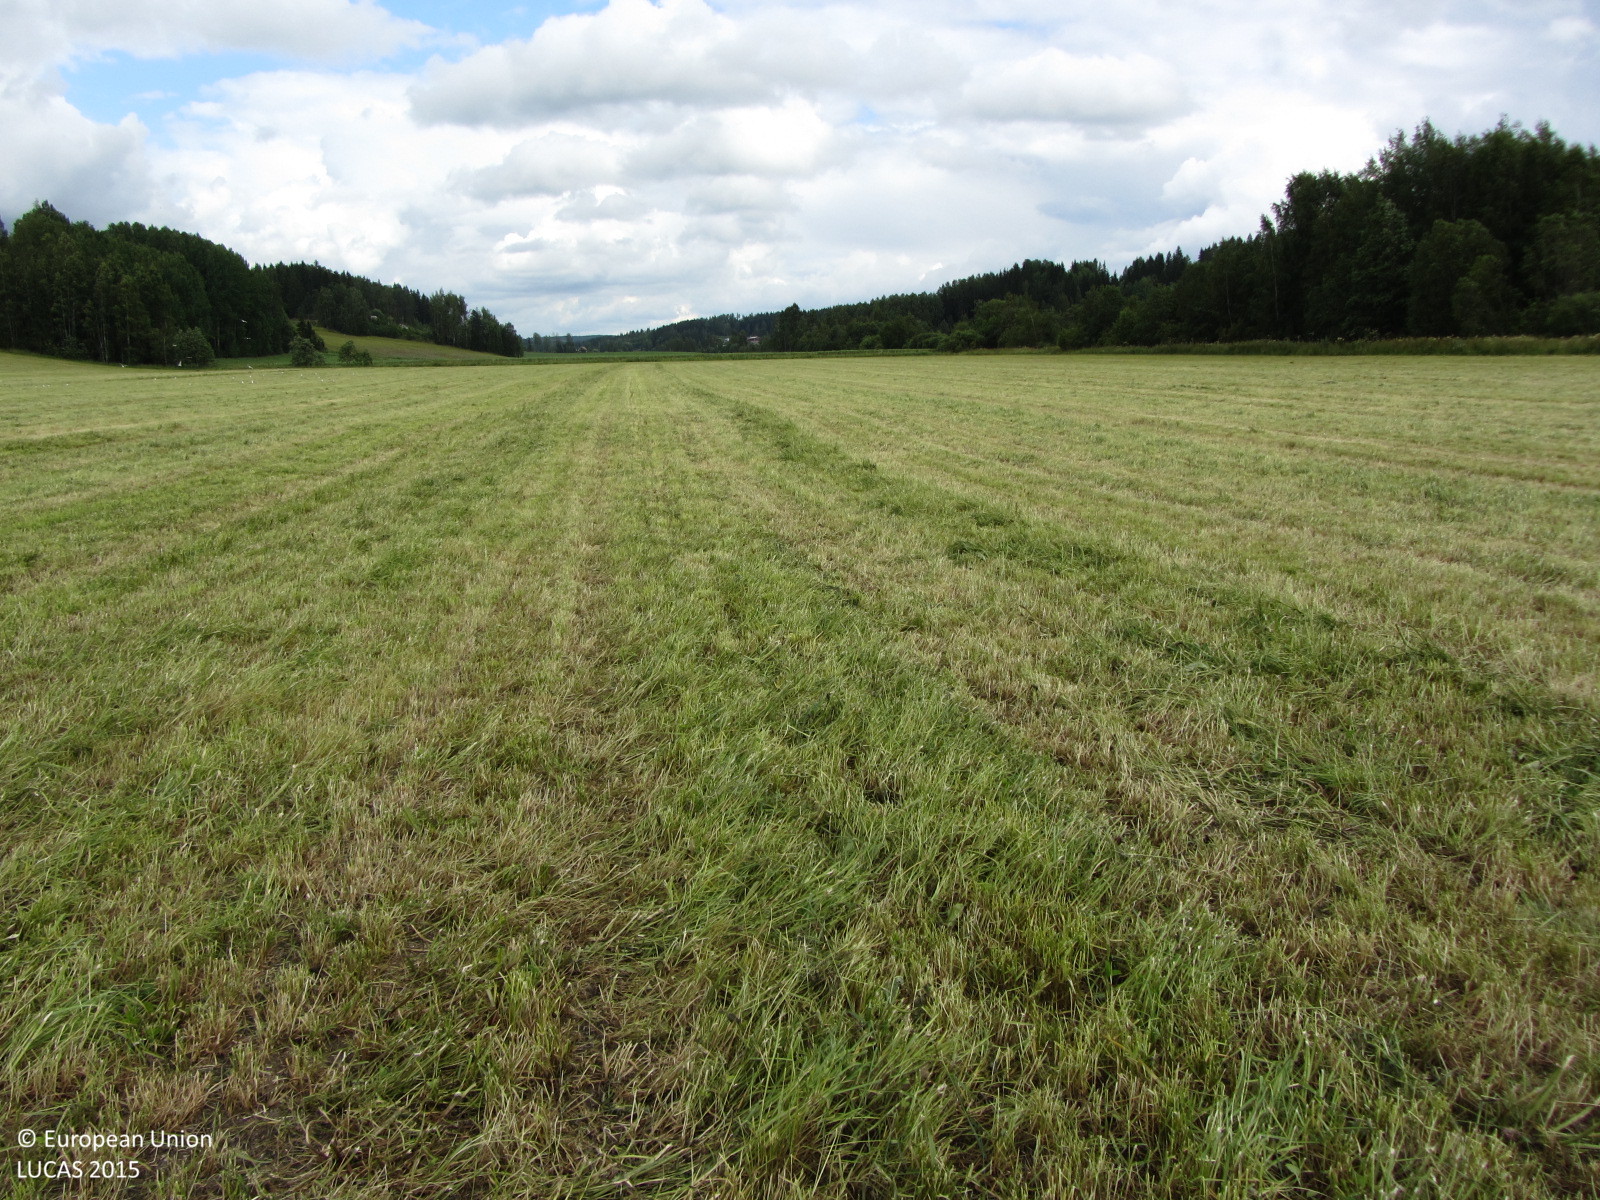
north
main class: Cropland
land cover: Temporary grasslands
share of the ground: > 75 %
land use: Agriculture (excluding fallow land and kitchen gardens)
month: July
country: FI
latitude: 60.4658
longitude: 24.3803
